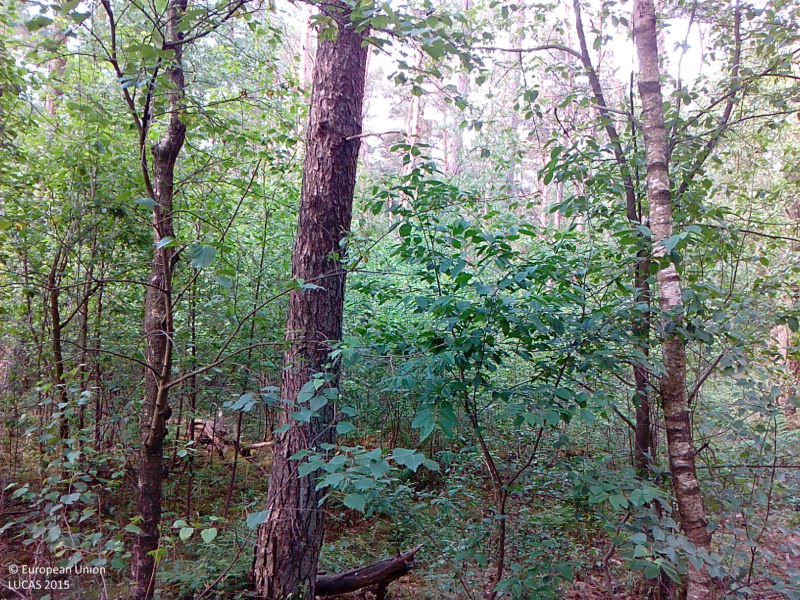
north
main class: Woodland
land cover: Pine dominated mixed woodland
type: hemiboreal forest and nemoral coniferous forest and mixed broadleaved-coniferous forest
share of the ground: > 75 %
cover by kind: coniferous forest trees 40 %, broadleaved forest trees 35 %, shrubs 15 %, herbaceous plants 10 %
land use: Forestry
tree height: > 5 m
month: June
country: DE
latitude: 52.4940
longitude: 7.4523
